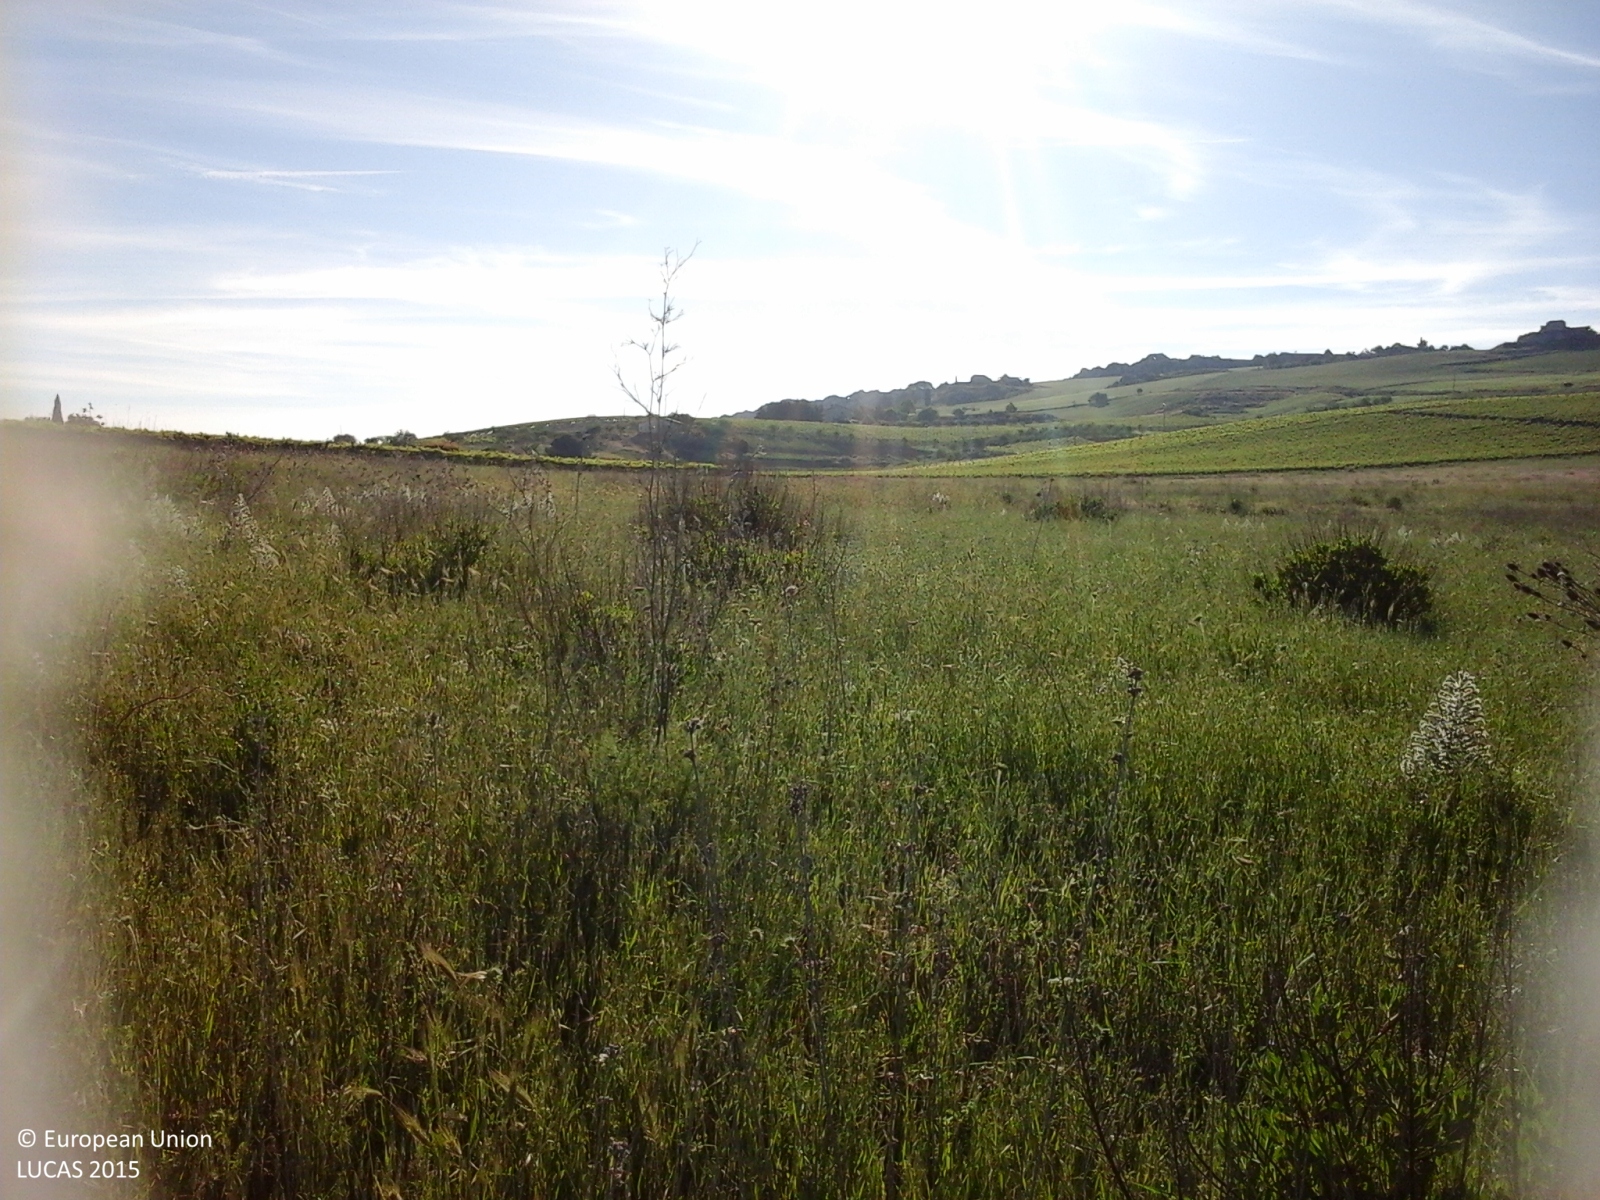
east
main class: Grassland
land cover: Spontaneously vegetated surfaces
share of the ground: > 75 %
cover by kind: herbaceous plants 100 %
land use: Fallow land
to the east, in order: Spontaneously vegetated surfaces; Vineyards
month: May
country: IT
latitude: 37.4316
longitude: 13.8920
